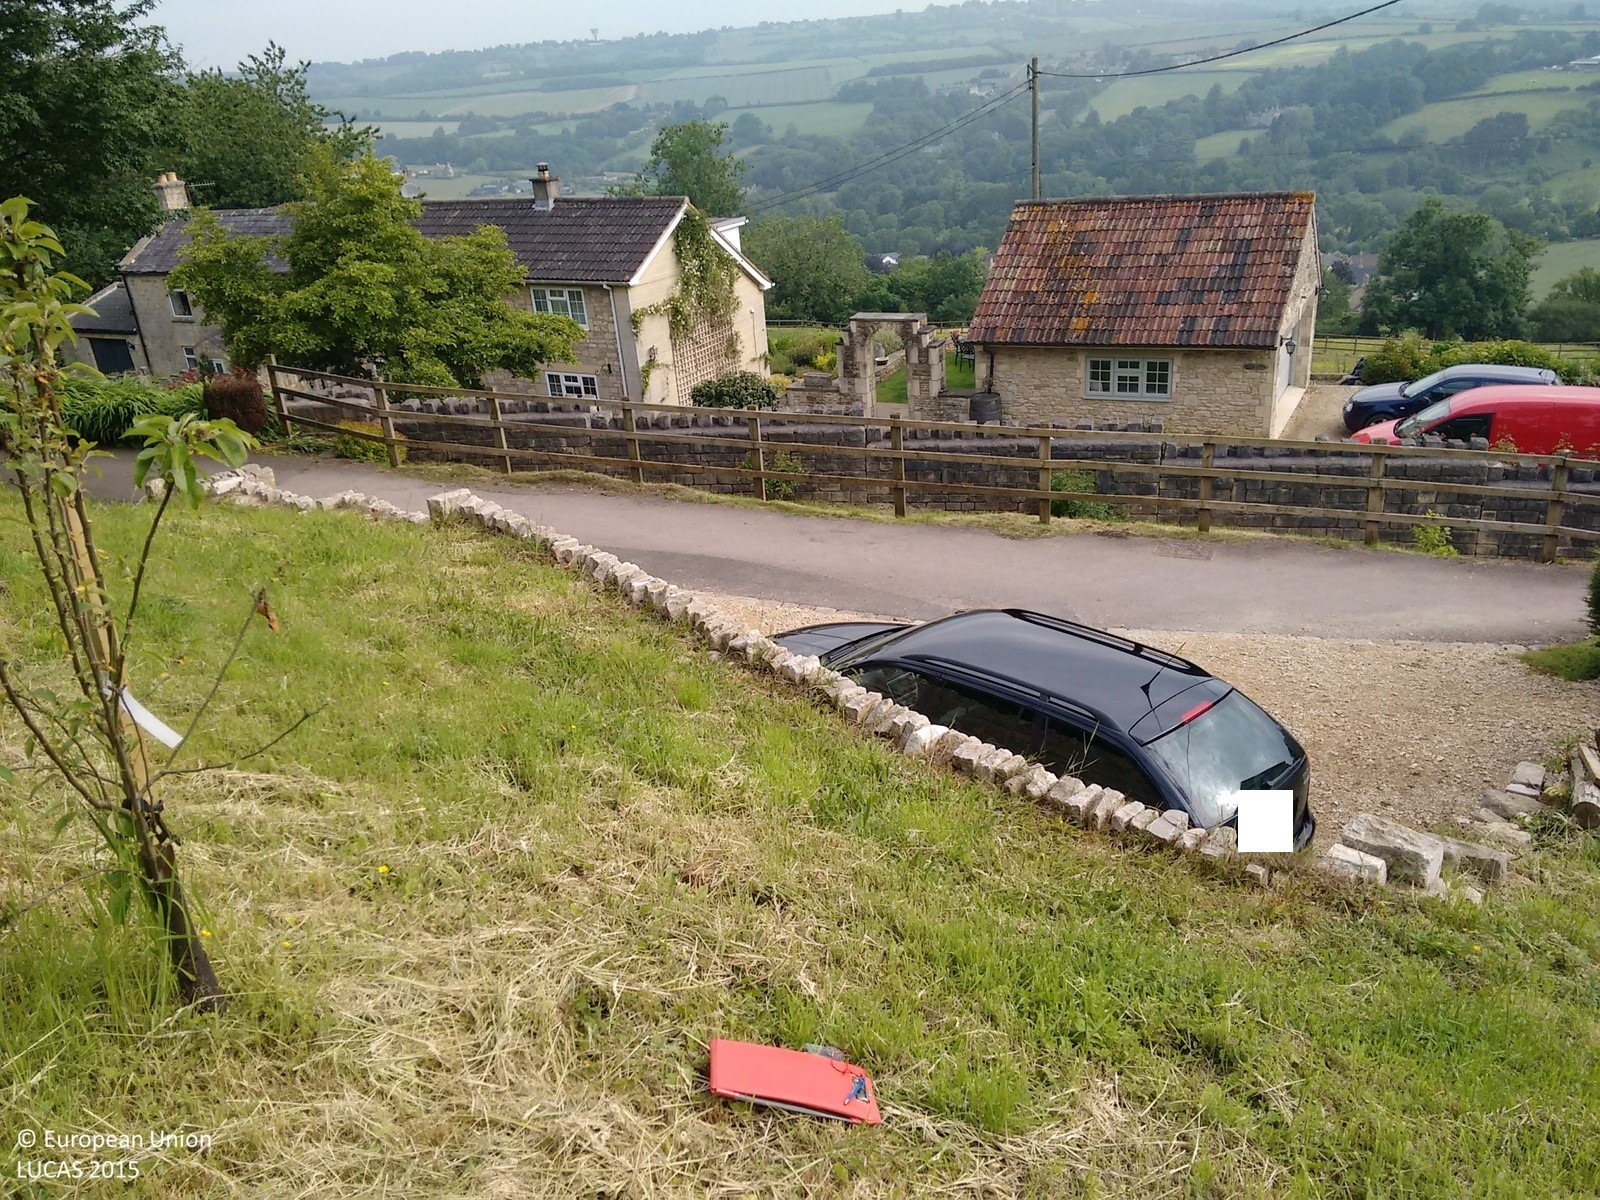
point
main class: Grassland
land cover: Grassland with sparse tree/shrub cover
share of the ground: > 75 %
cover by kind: herbaceous plants 95 %, broadleaved forest trees 5 %
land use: Residential
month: June
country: GB
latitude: 51.4106
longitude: -2.2690
